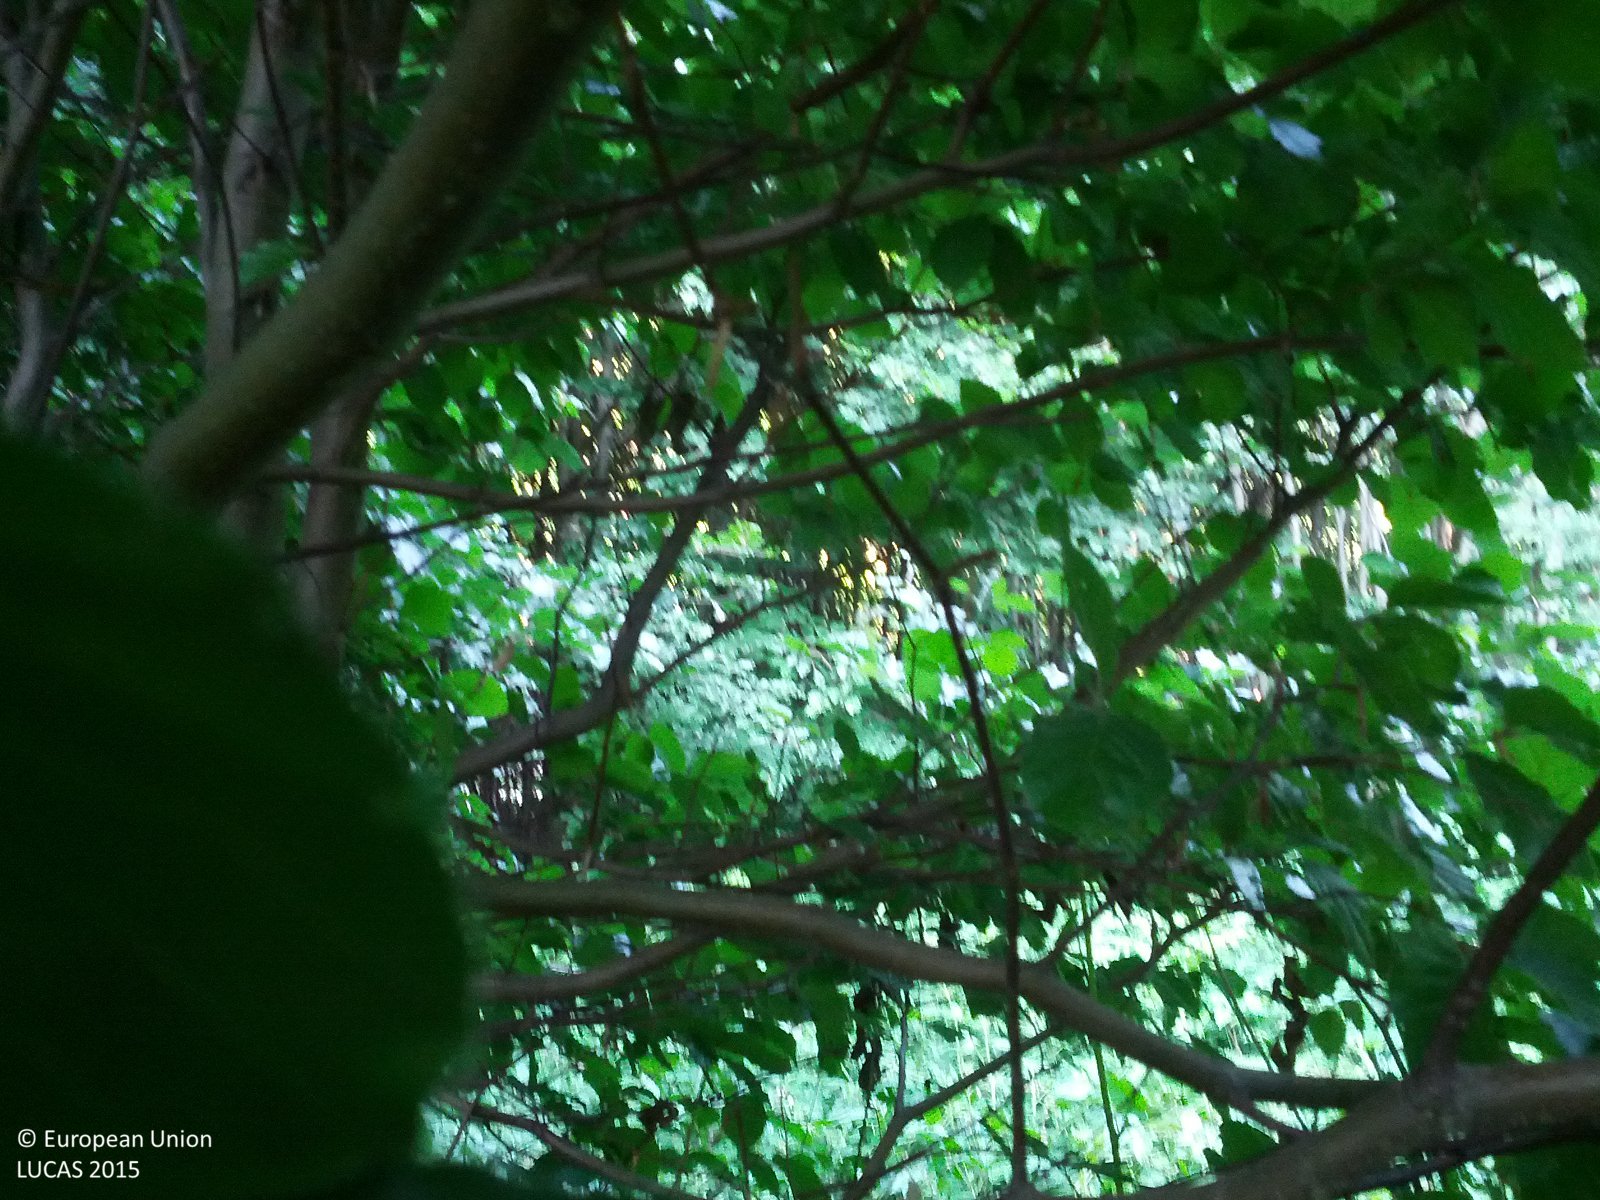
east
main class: Shrubland
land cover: Shrubland with sparse tree cover
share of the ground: > 75 %
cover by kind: shrubs 75 %, herbaceous plants 20 %, broadleaved forest trees 5 %
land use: Forestry
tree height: > 5 m
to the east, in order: Shrubland with sparse tree cover; Broadleaved woodland; Tracks; Broadleaved woodland; Rivers and streams; Broadleaved woodland
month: June
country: AT
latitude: 48.1482
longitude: 16.0388
